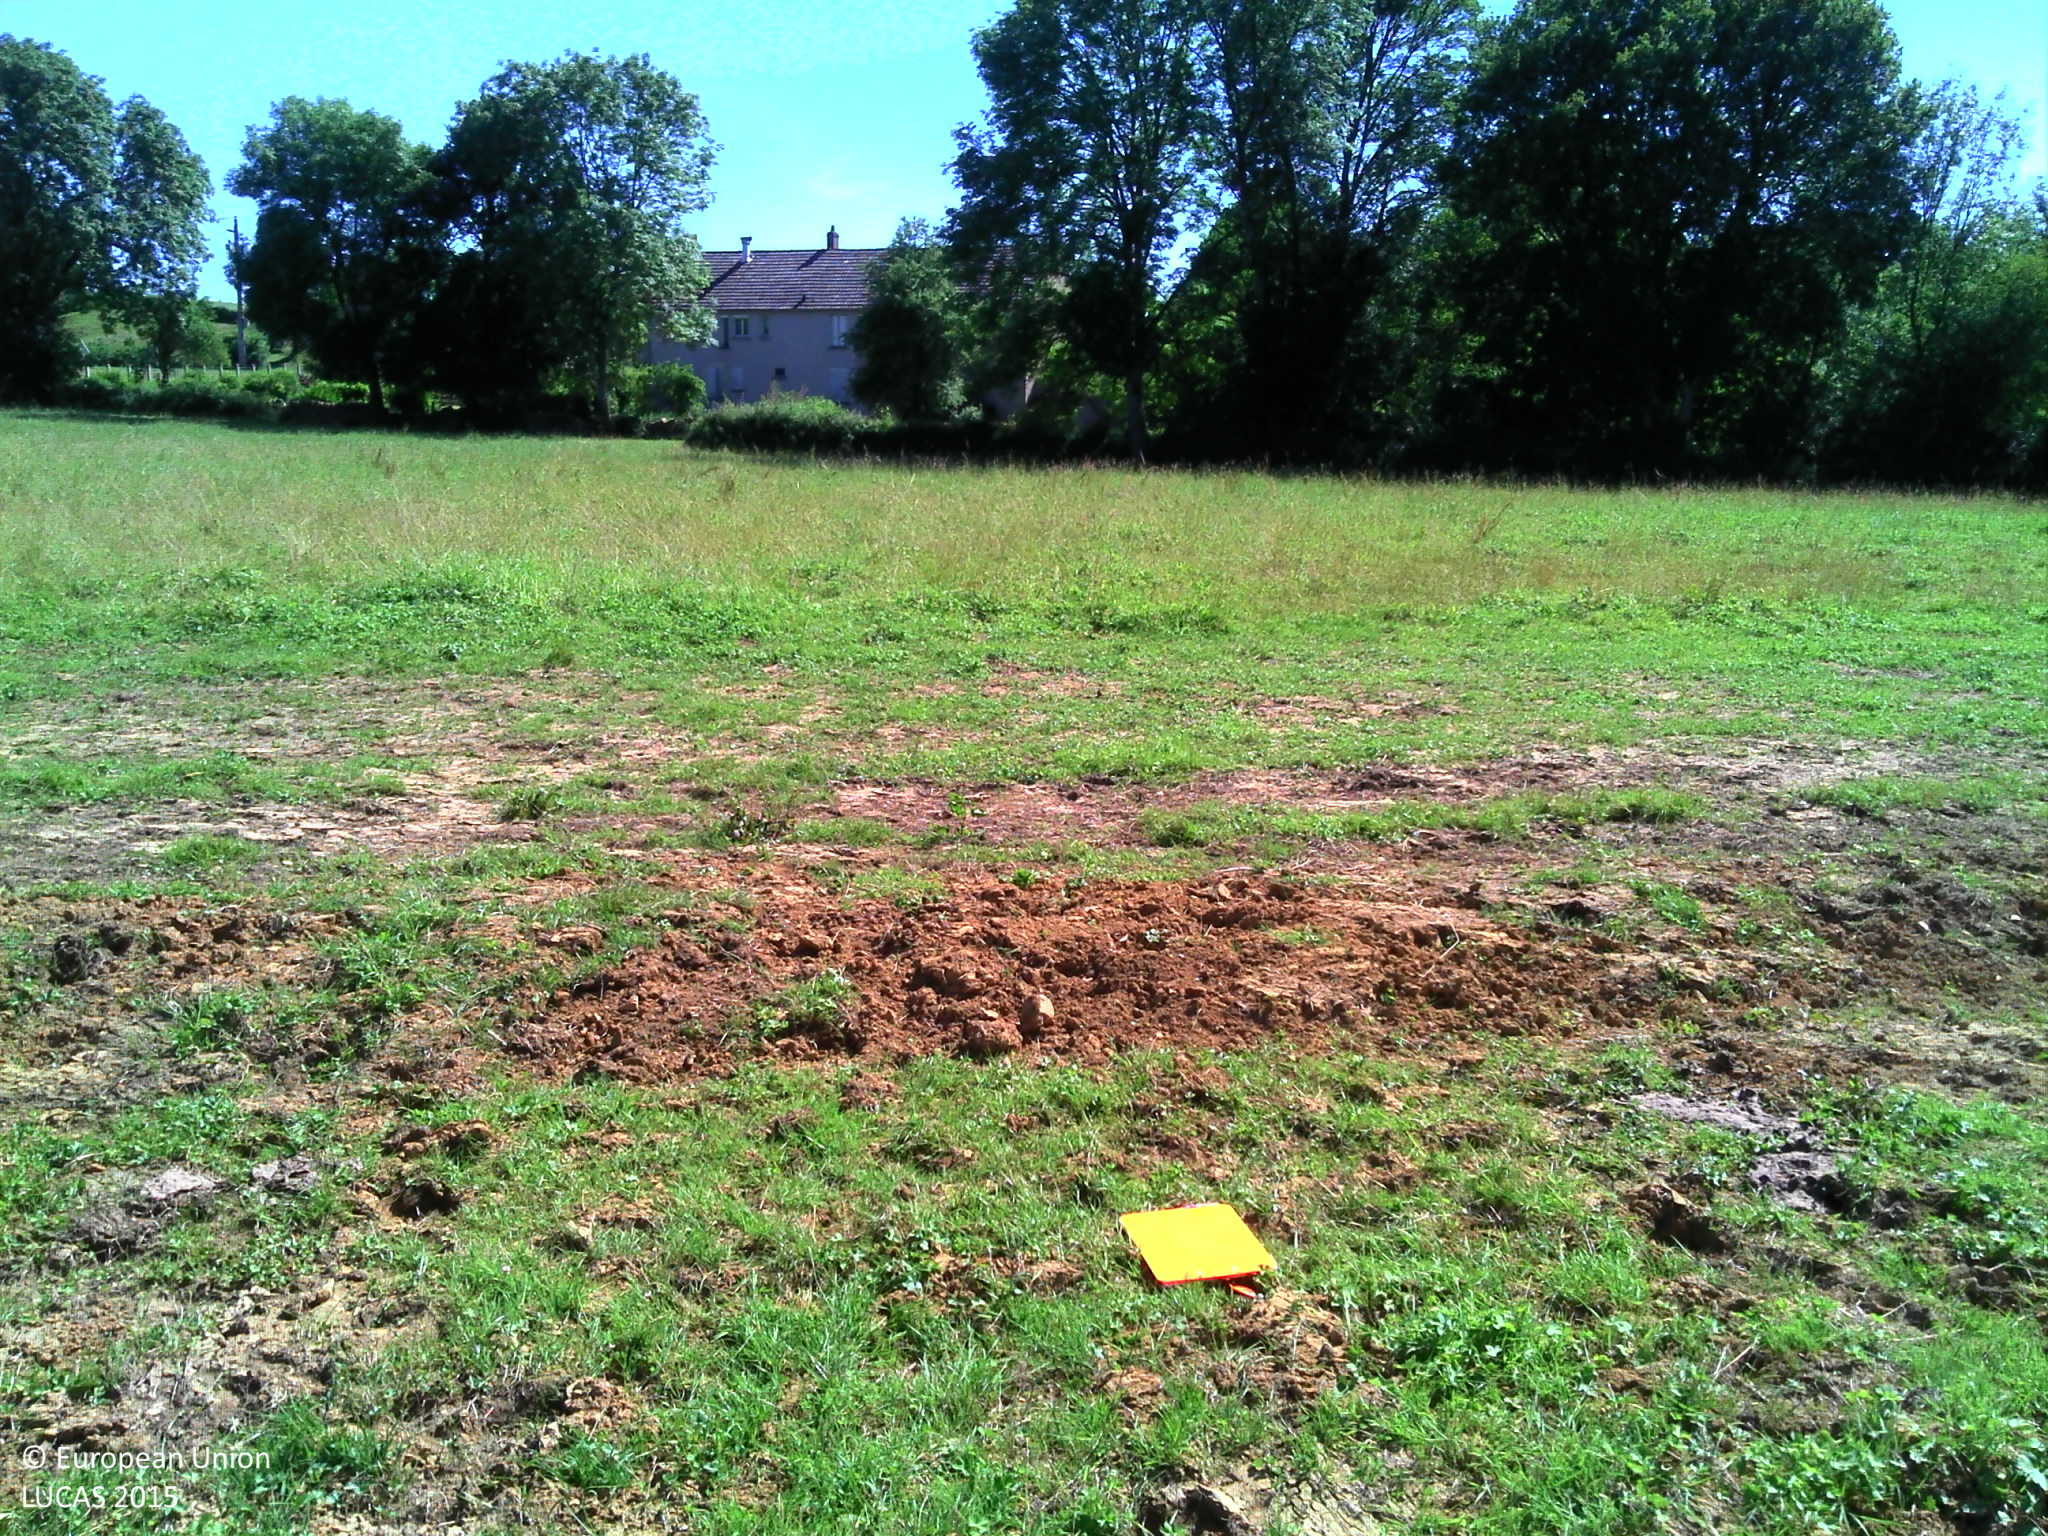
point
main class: Grassland
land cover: Grassland without tree/shrub cover
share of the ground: > 75 %
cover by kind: herbaceous plants 100 %
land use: Agriculture (excluding fallow land and kitchen gardens)
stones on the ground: < 10 %
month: June
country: FR
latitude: 47.3634
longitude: 3.4952
